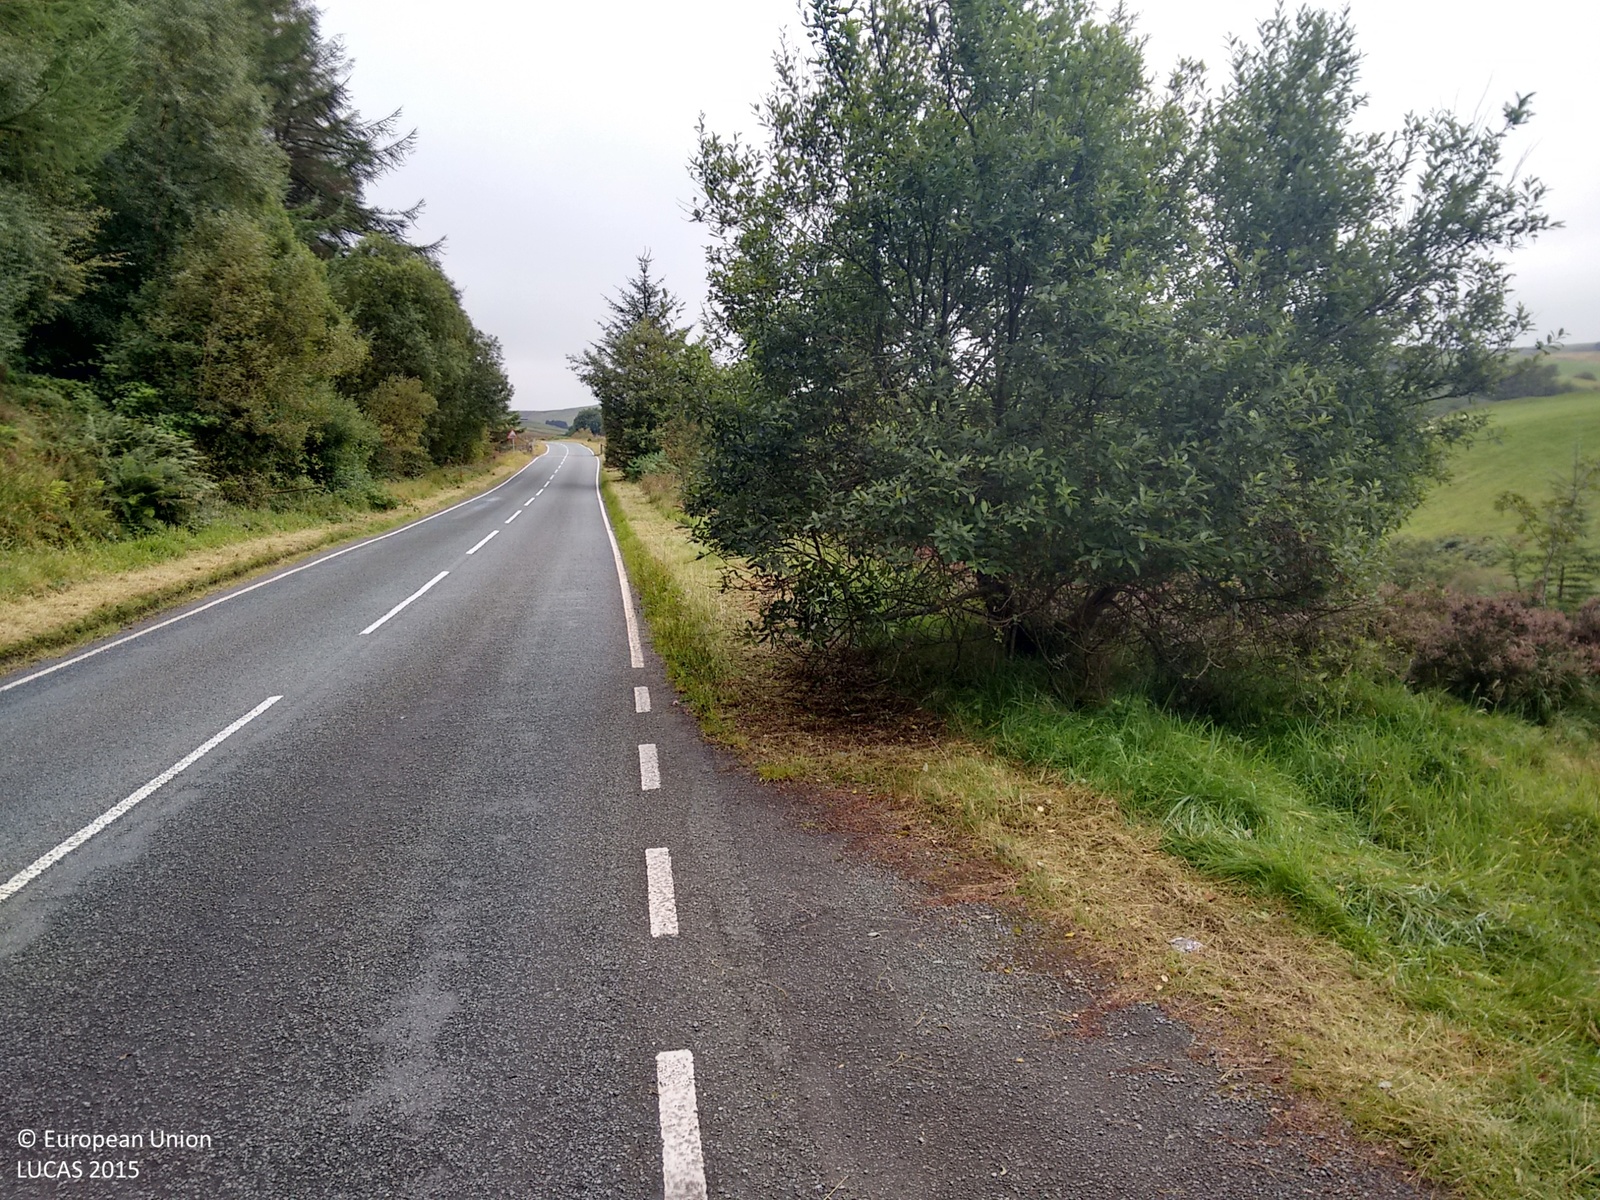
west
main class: Woodland
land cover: Pine dominated coniferous woodland
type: exotic forest
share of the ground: > 75 %
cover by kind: coniferous forest trees 95 %, broadleaved forest trees 5 %
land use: Forestry
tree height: > 5 m
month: September
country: GB
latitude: 52.5312
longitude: -3.6643
